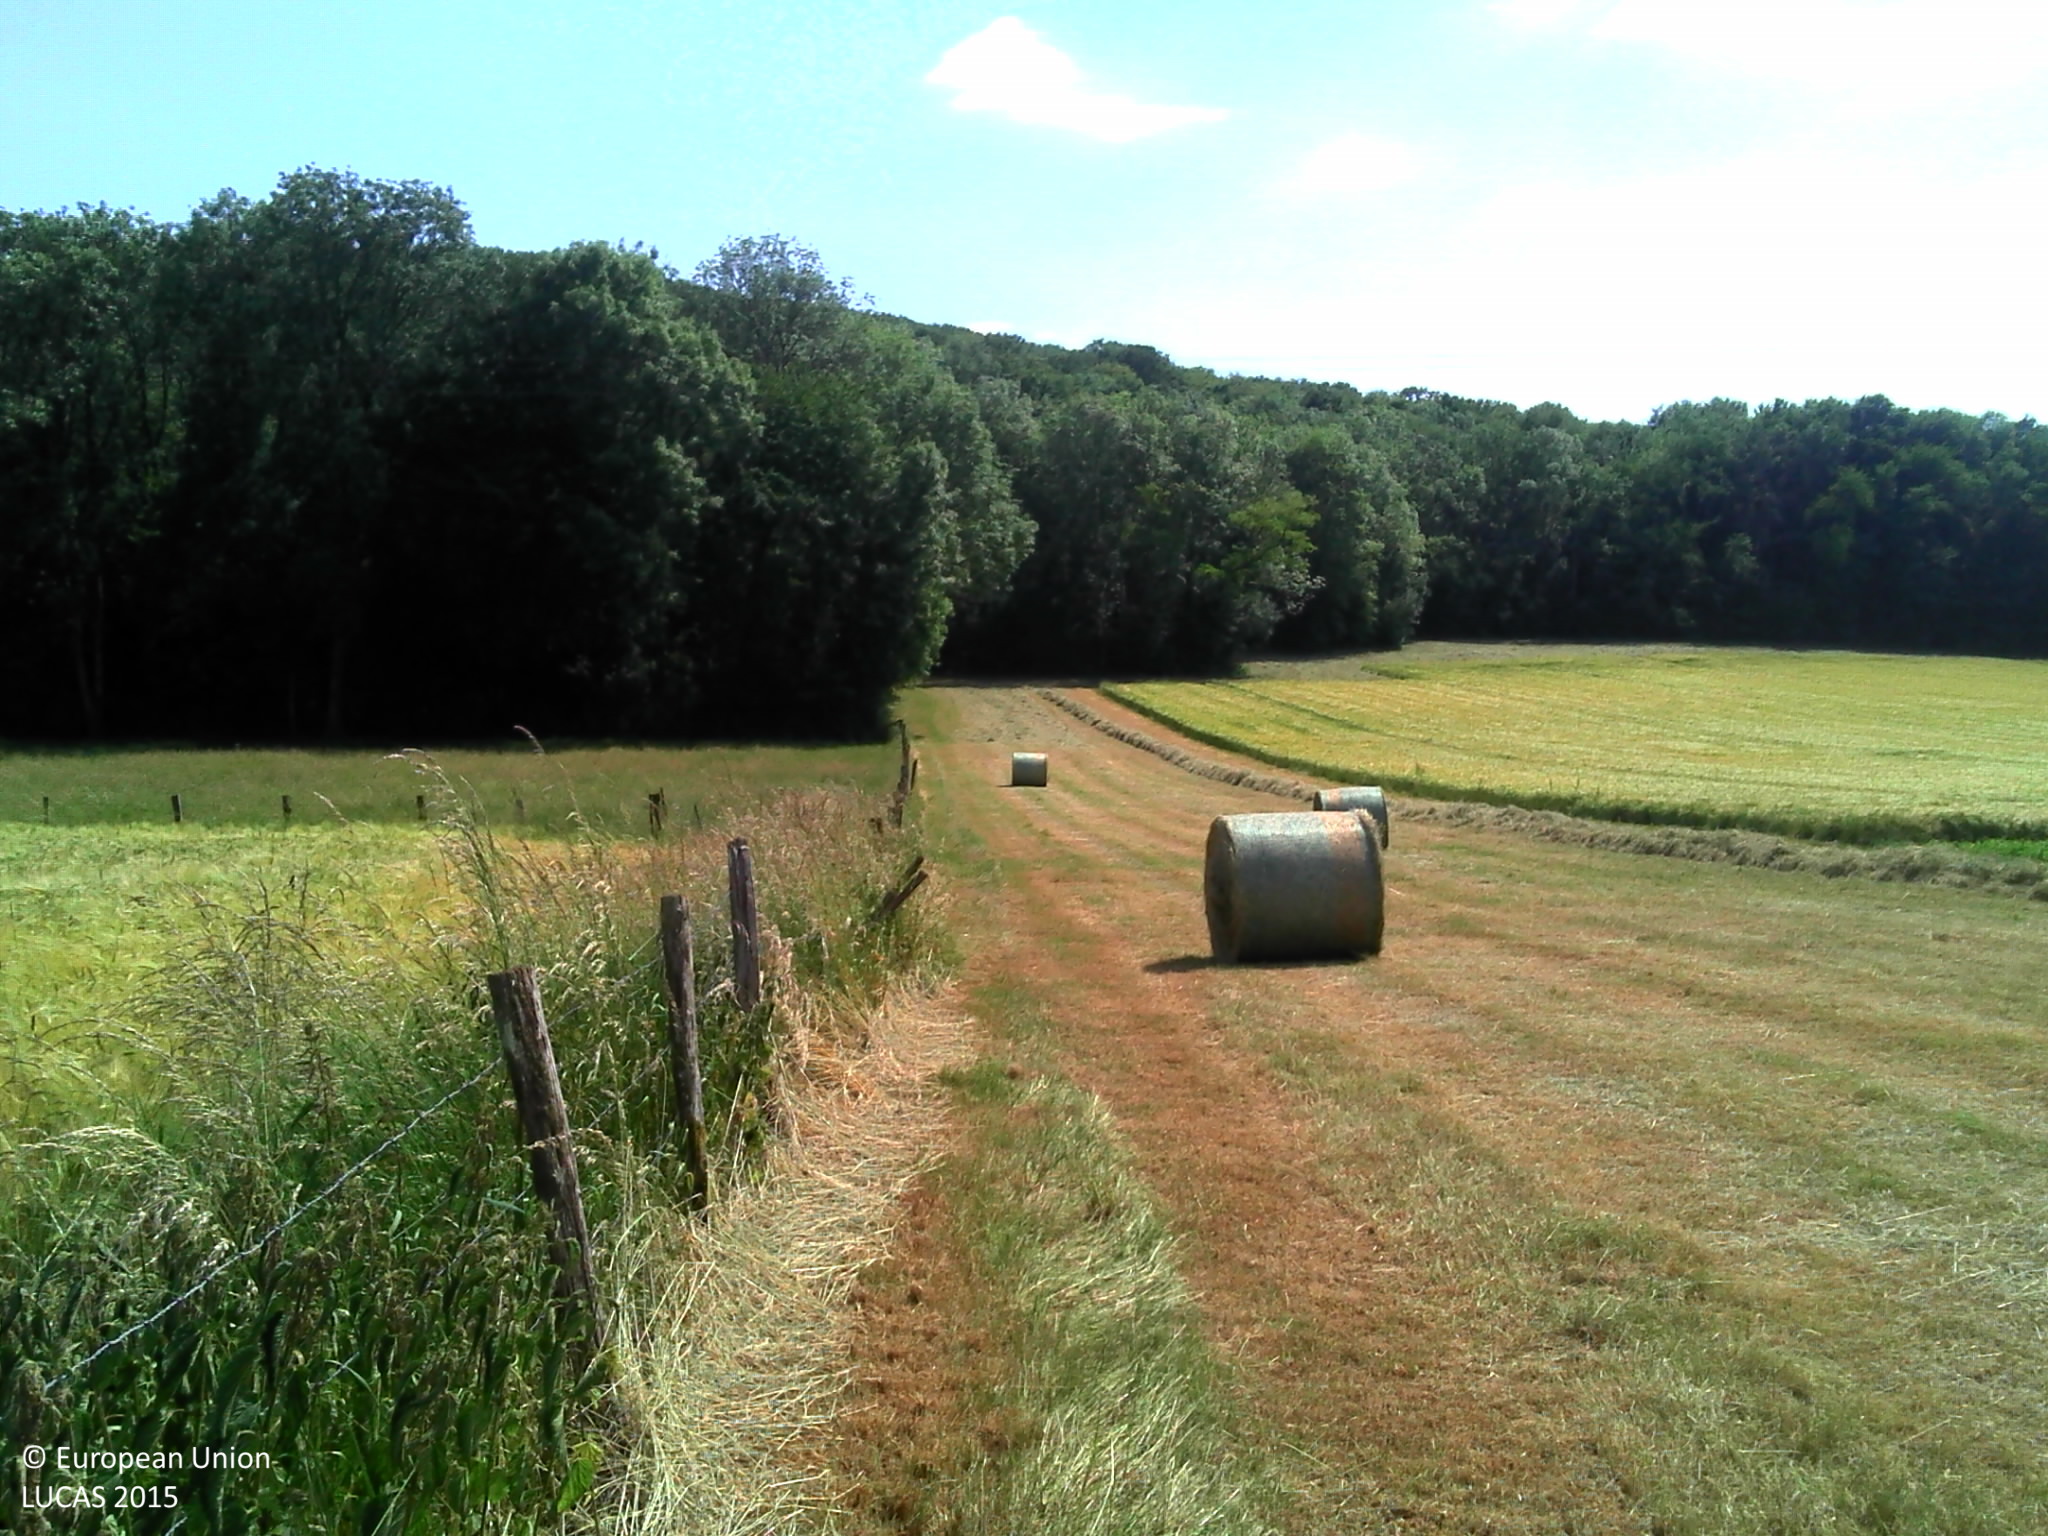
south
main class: Cropland
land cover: Barley
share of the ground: > 75 %
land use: Agriculture (excluding fallow land and kitchen gardens)
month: June
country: FR
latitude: 47.5496
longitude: 6.3208
